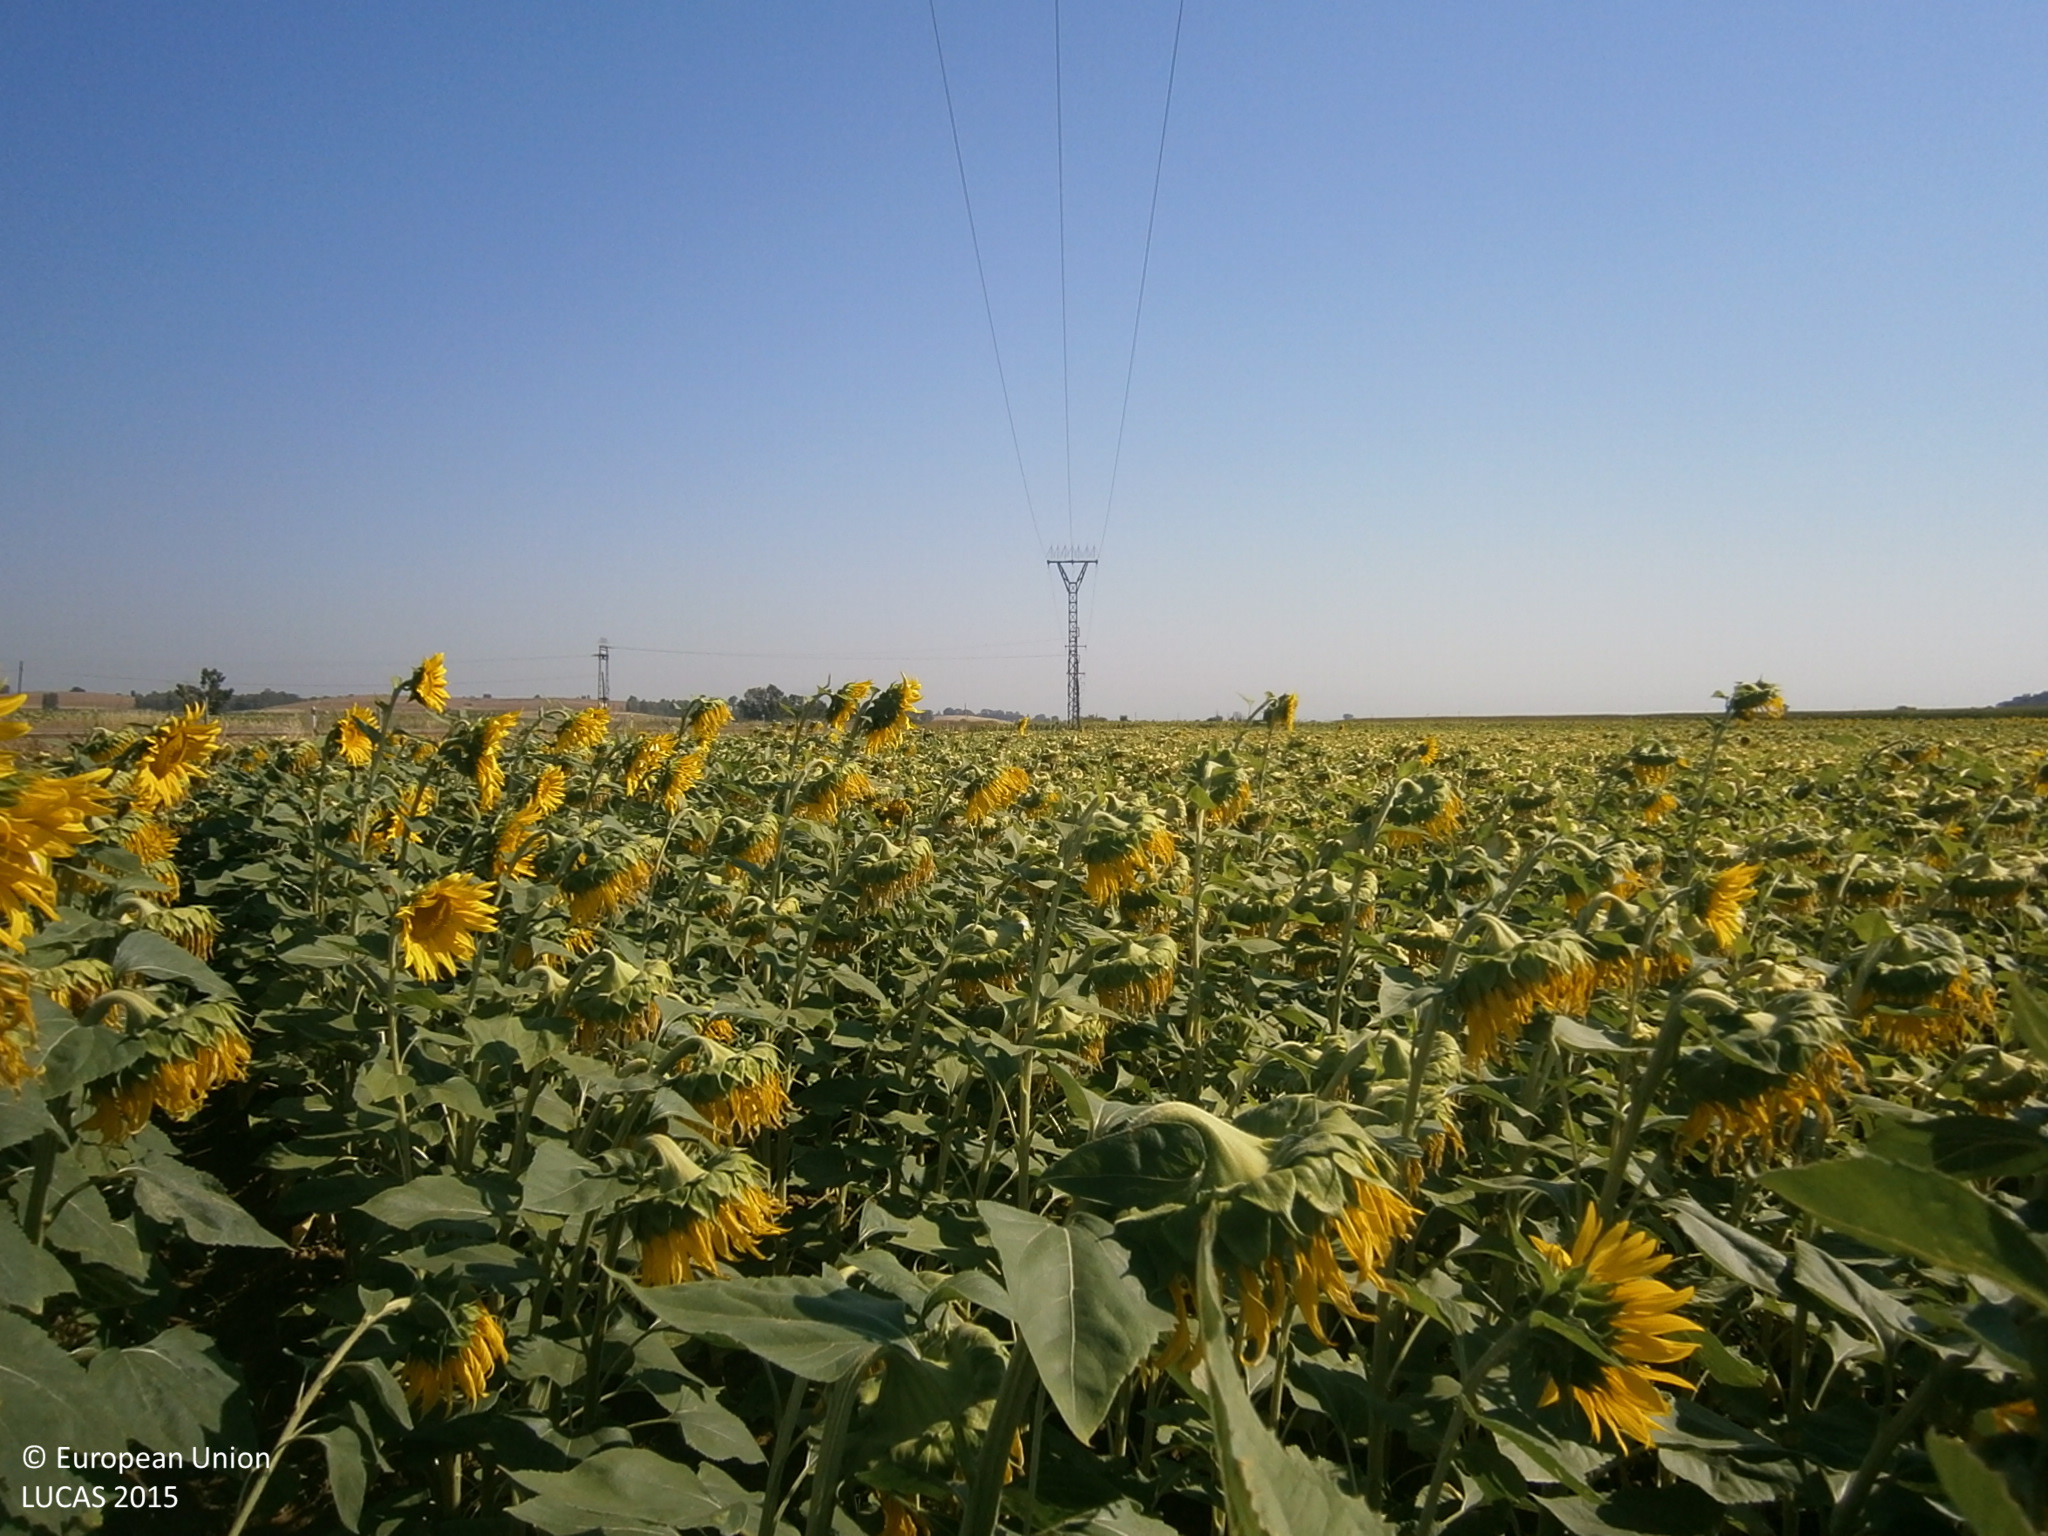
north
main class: Cropland
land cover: Sunflower
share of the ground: > 75 %
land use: Agriculture (excluding fallow land and kitchen gardens)
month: June
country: ES
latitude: 38.8291
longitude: -6.7790
